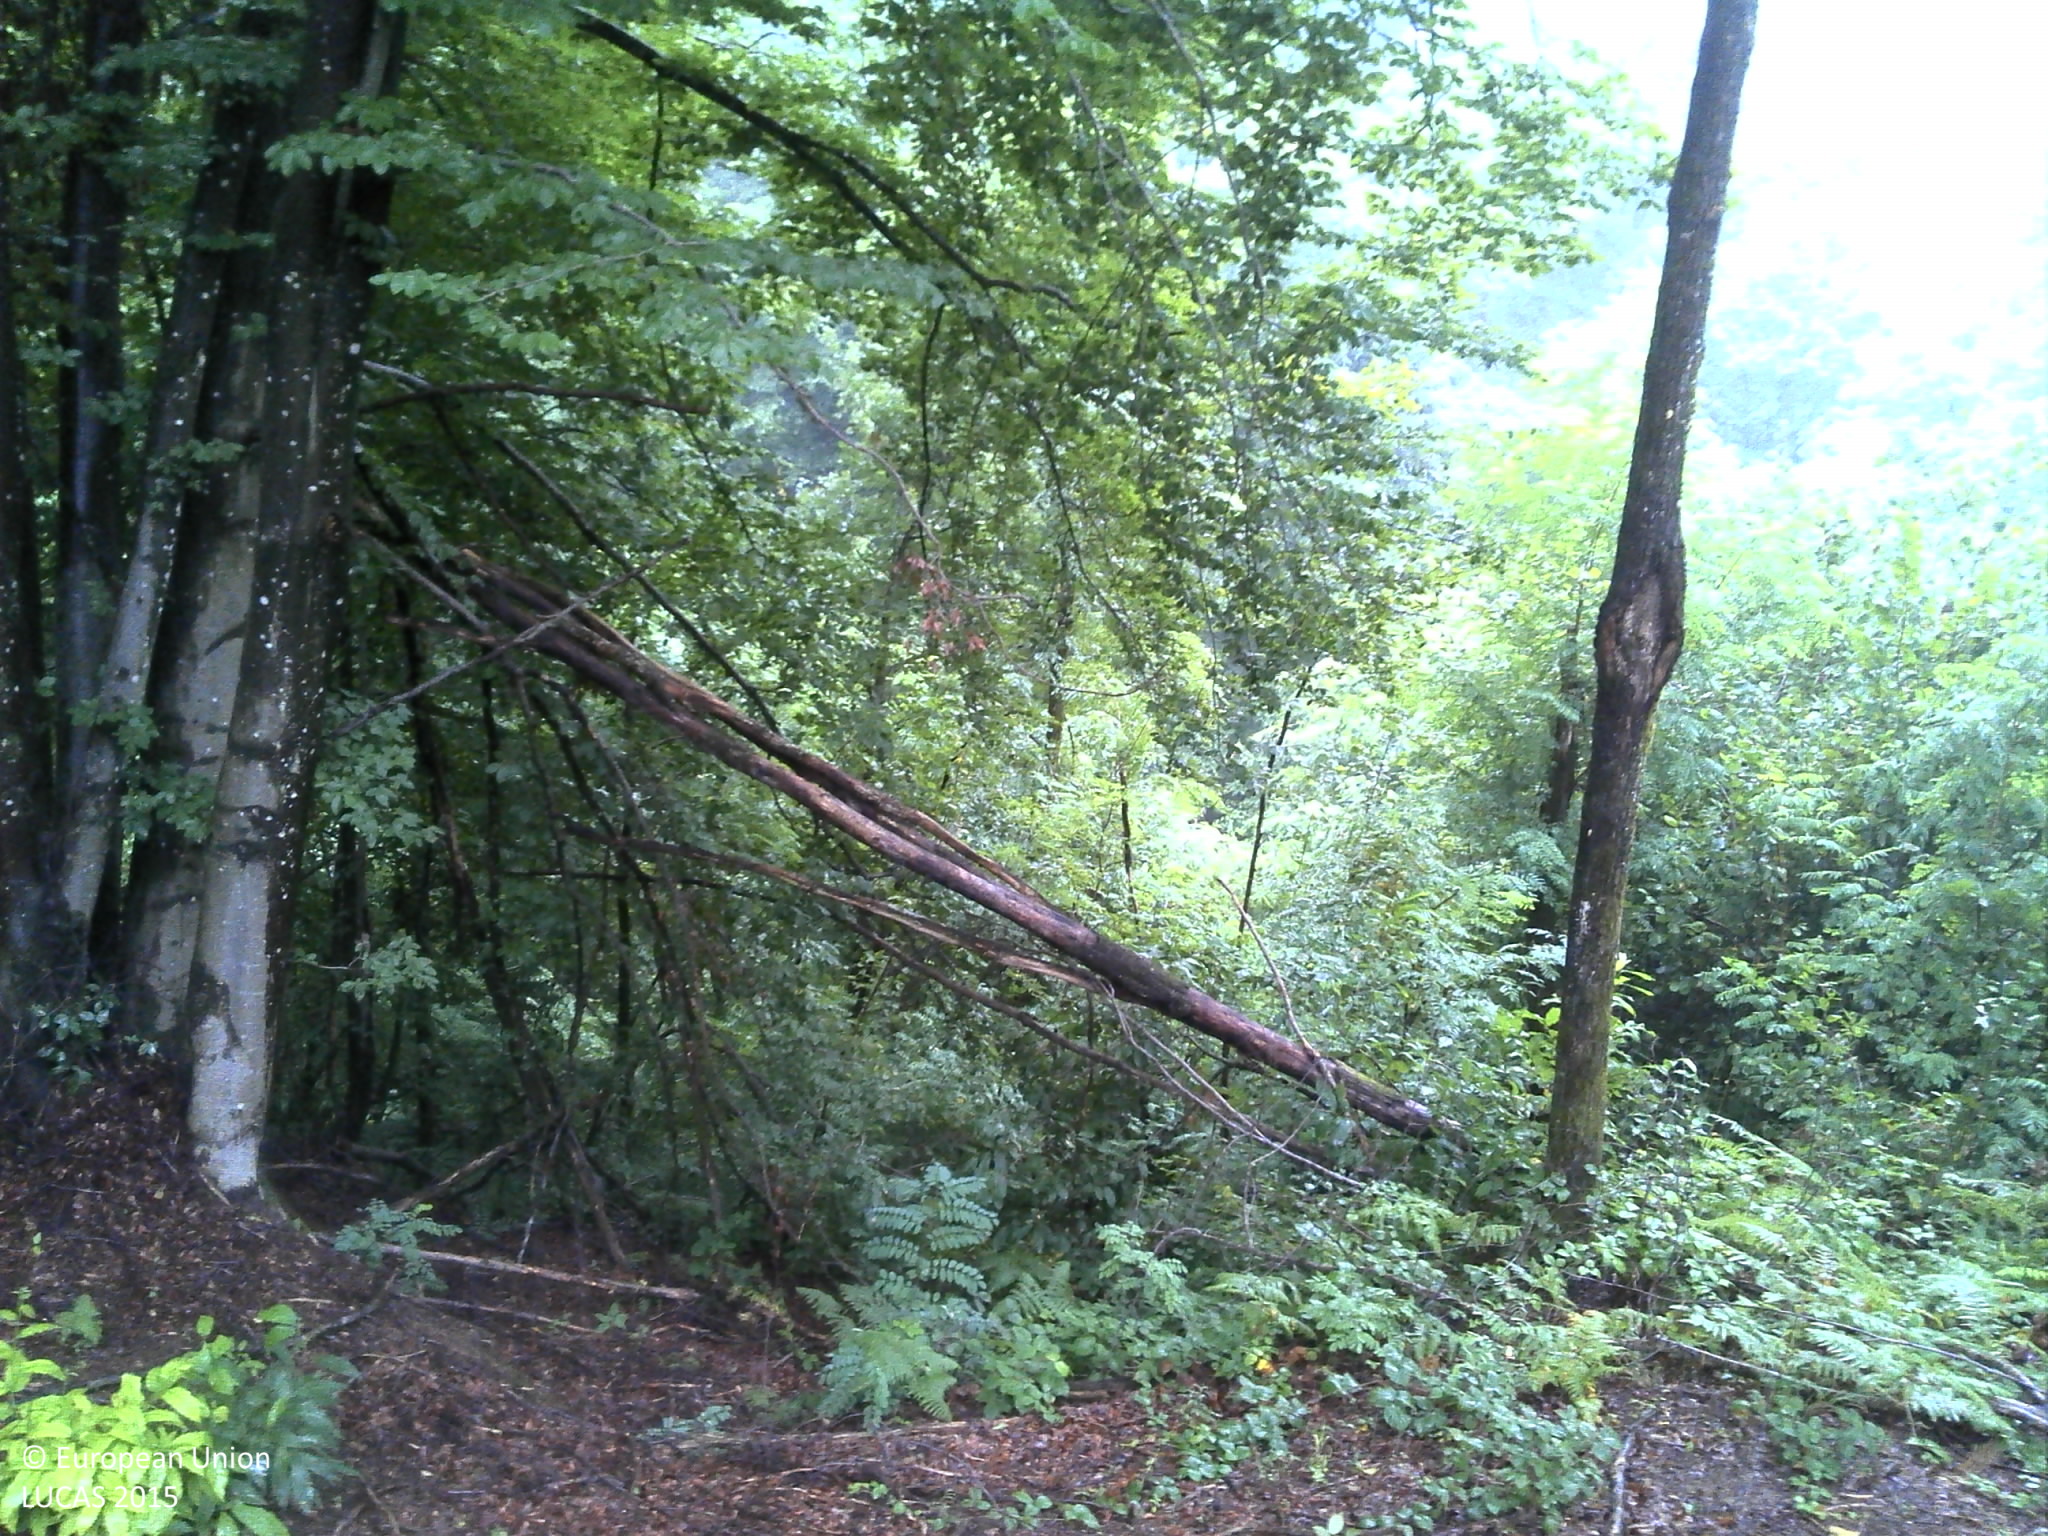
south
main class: Woodland
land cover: Broadleaved woodland
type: beech forest
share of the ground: > 75 %
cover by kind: broadleaved forest trees 100 %
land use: Forestry
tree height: > 5 m
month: August
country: HR
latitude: 45.4761
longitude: 15.7146
